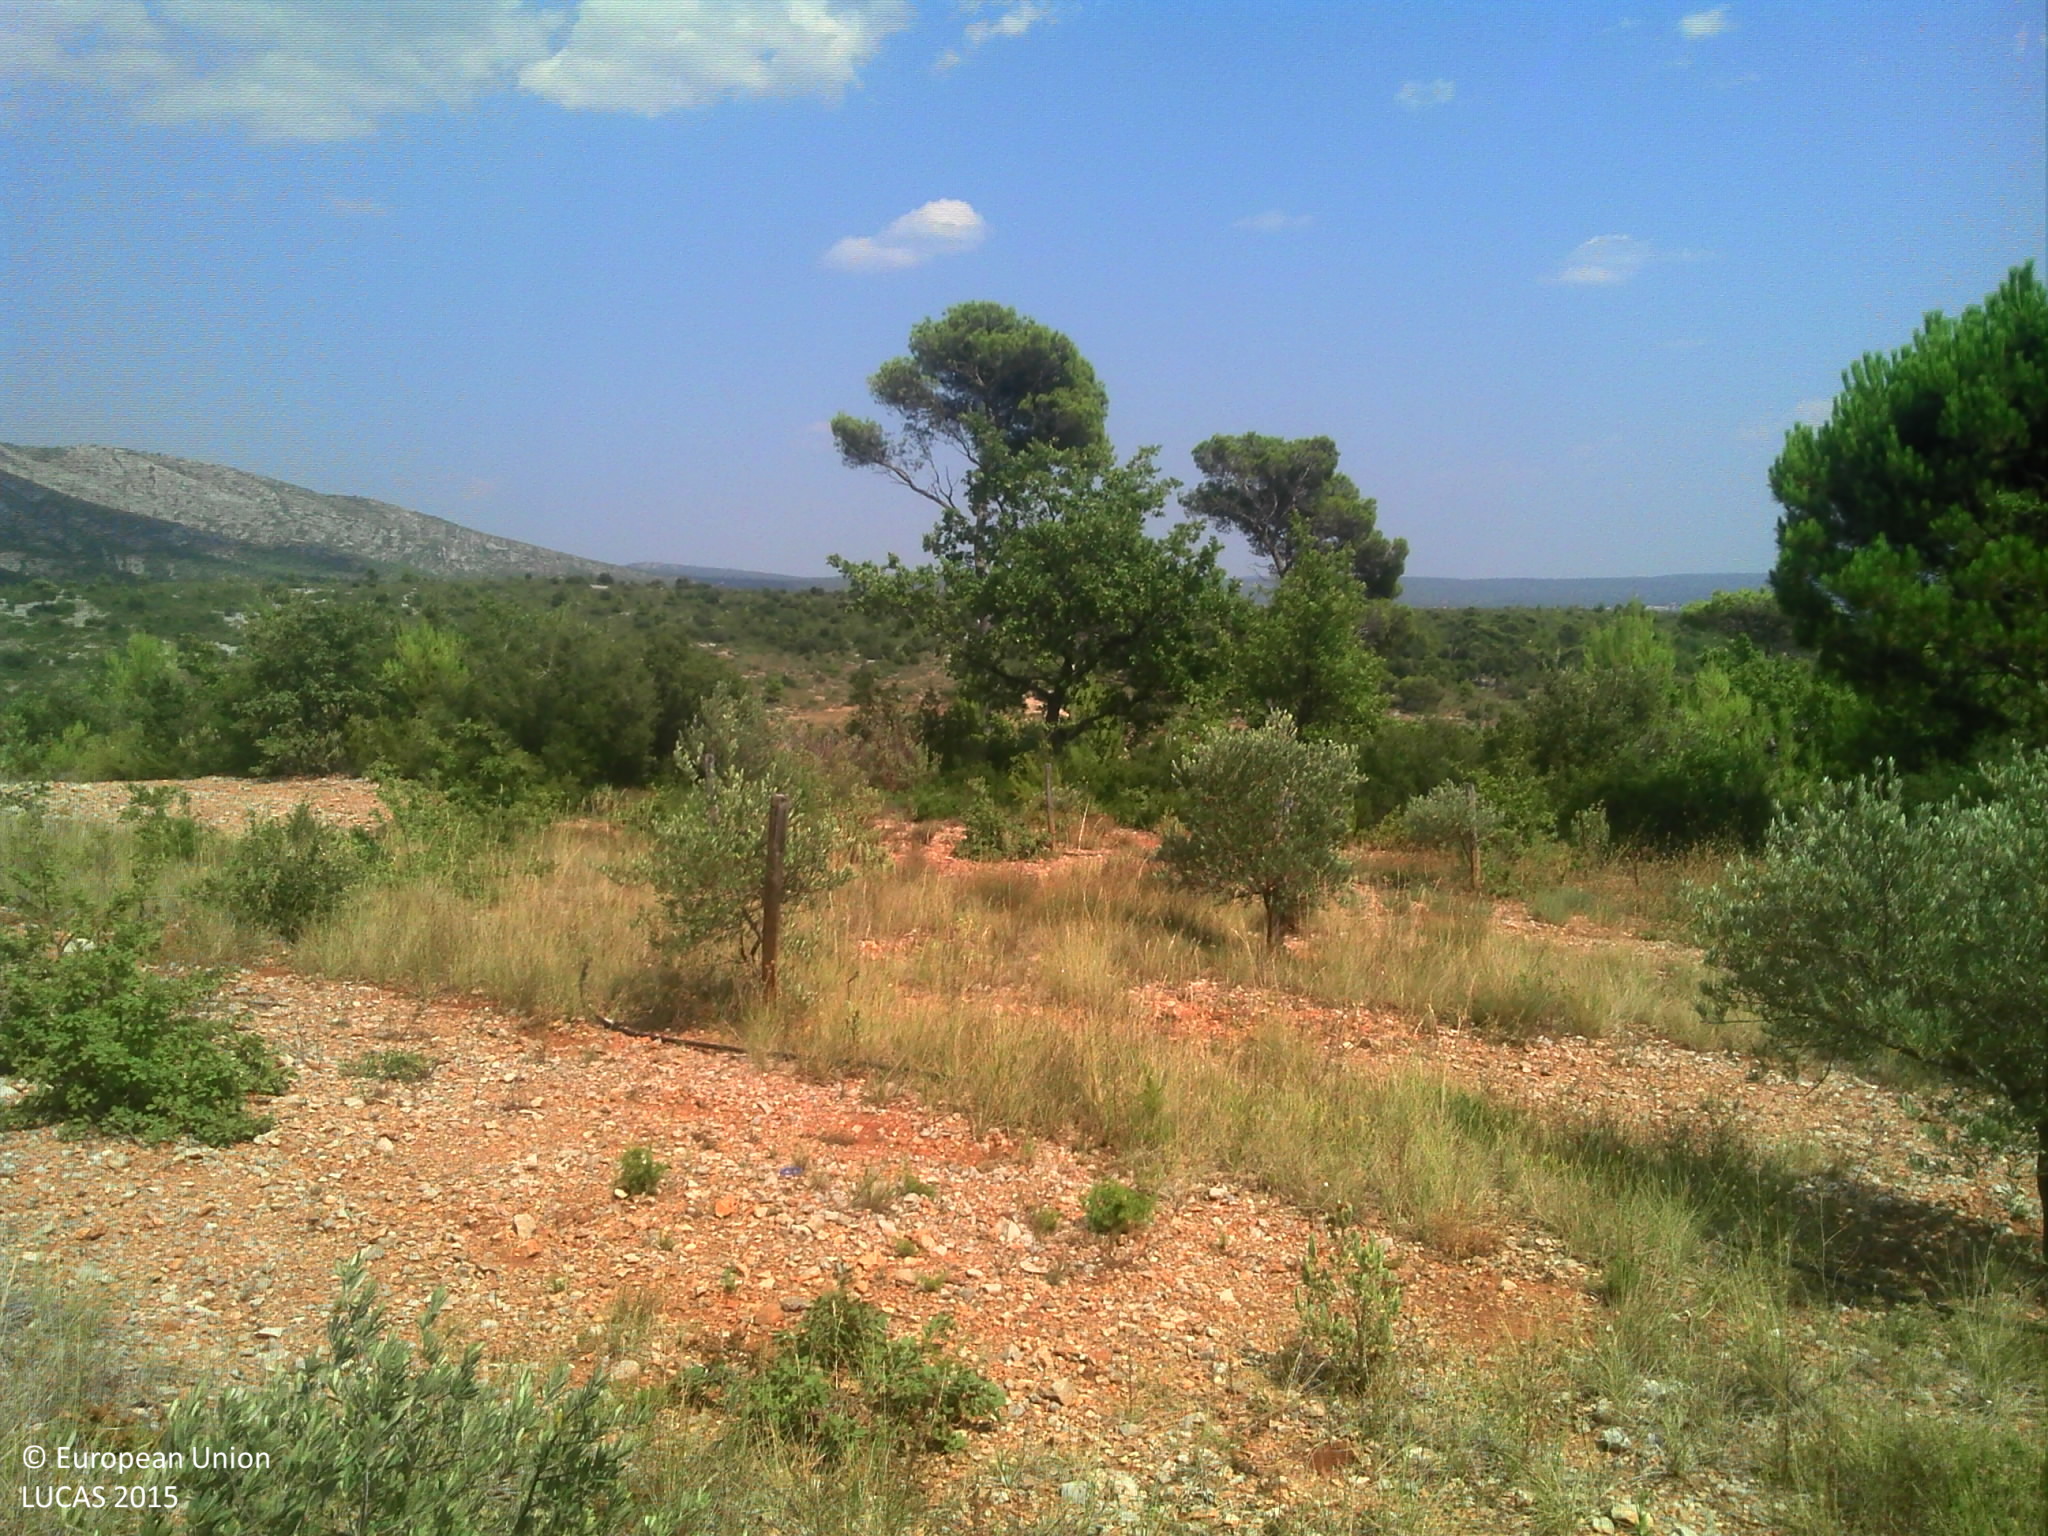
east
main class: Cropland
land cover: Olive groves
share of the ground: 25 - 50 %
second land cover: Other bare soil
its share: > 75 %
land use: Agriculture (excluding fallow land and kitchen gardens)
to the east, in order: Tracks; Olive groves; Other bare soil; Pine dominated mixed woodland; Tracks; Shrubland without tree cover; Rock outcrops; Shrubland without tree cover; Pine dominated mixed woodland; Ditches and canals; Tracks; Shrubland without tree cover; Broadleaved woodland; Grassland with sparse tree/shrub cover
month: August
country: FR
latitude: 43.5184
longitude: 5.6425
